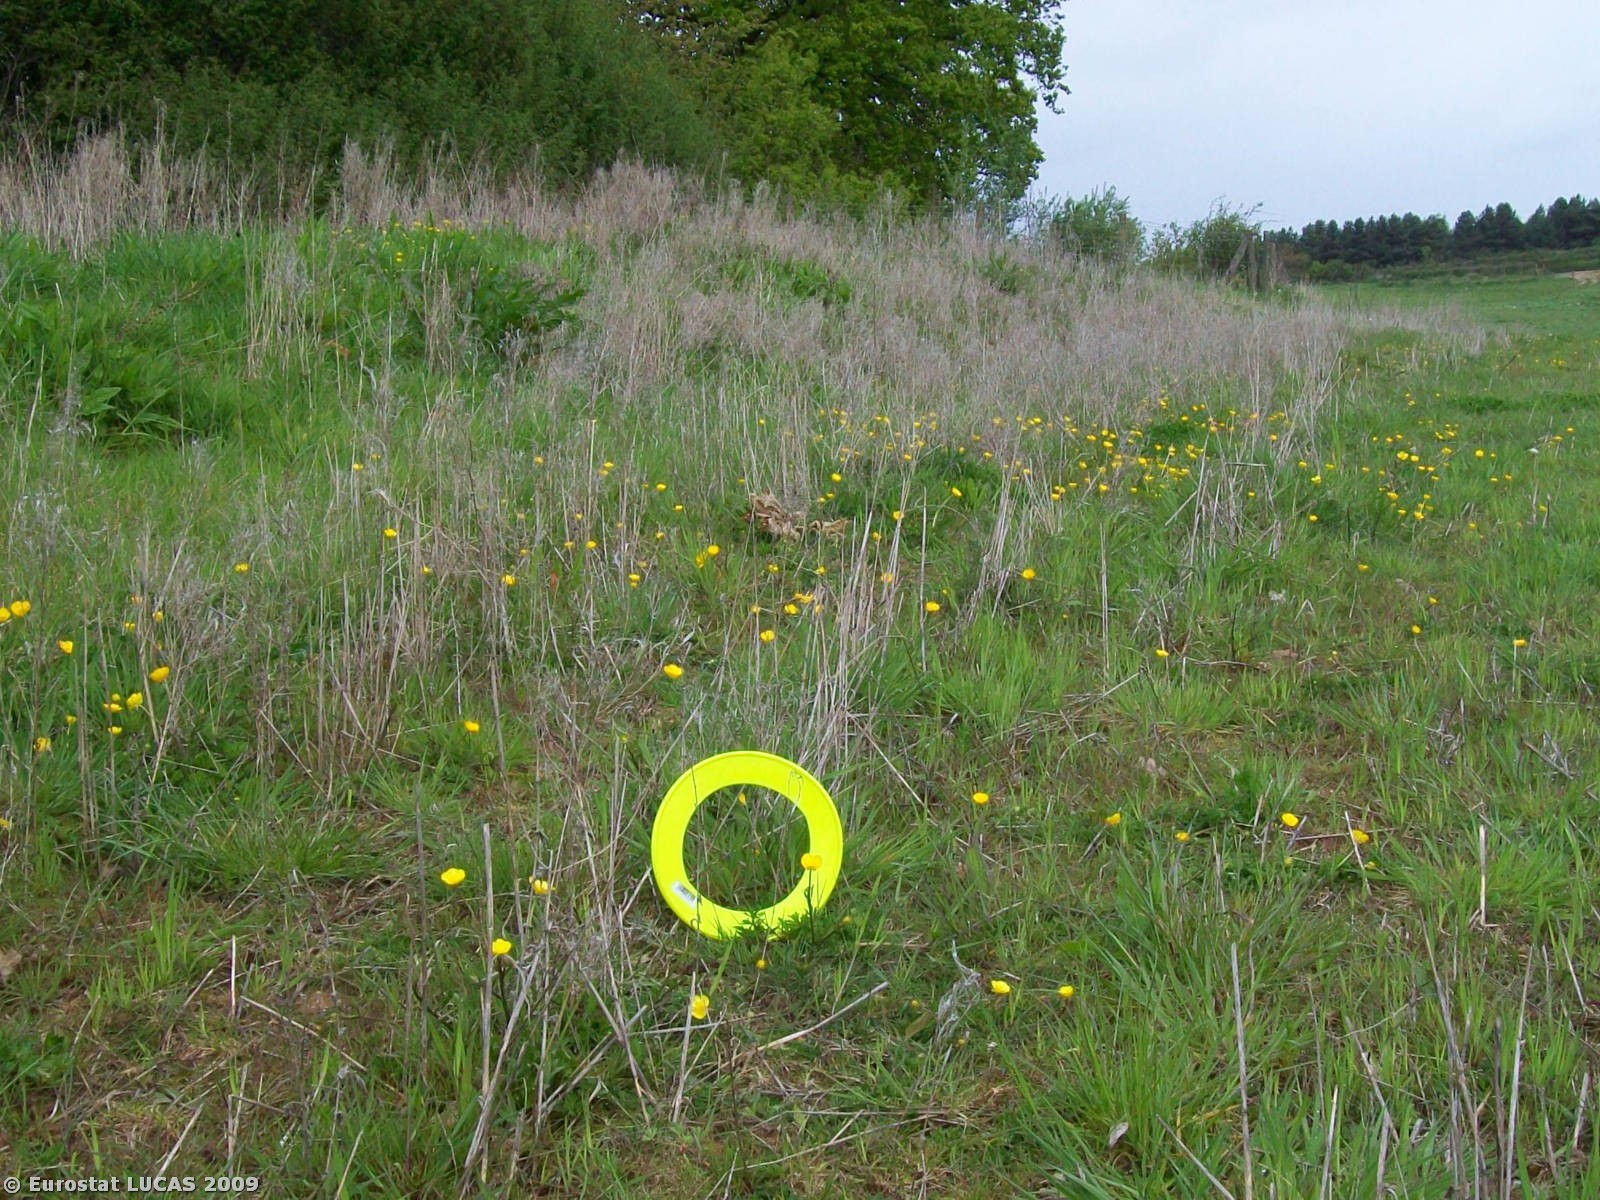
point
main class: Grassland
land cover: Grassland without tree/shrub cover
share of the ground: > 75 %
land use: Agriculture (excluding fallow land and kitchen gardens)
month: May
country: GB
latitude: 52.4242
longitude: -2.4923
